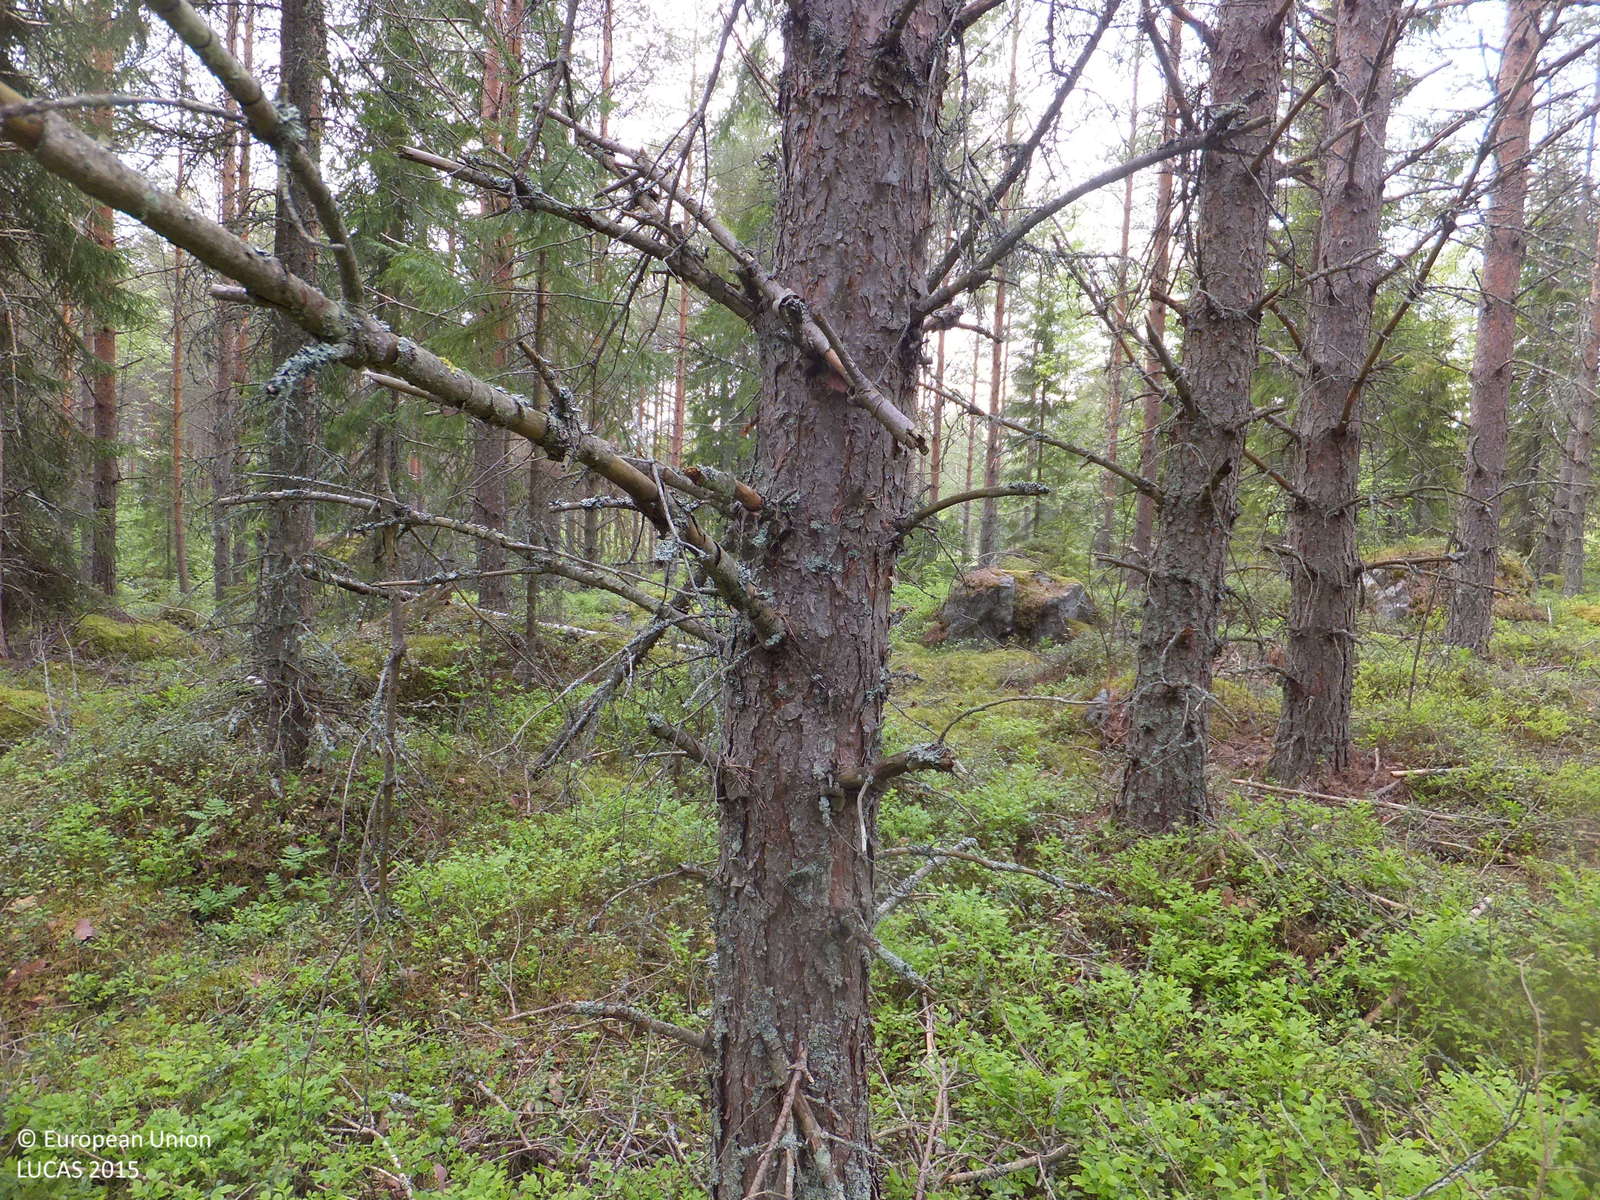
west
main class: Woodland
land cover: Pine dominated coniferous woodland
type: boreal forest
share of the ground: > 75 %
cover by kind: coniferous forest trees 95 %, lichens and mosses 5 %
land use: Forestry
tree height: > 5 m
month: June
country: FI
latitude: 63.5483
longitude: 22.3392
